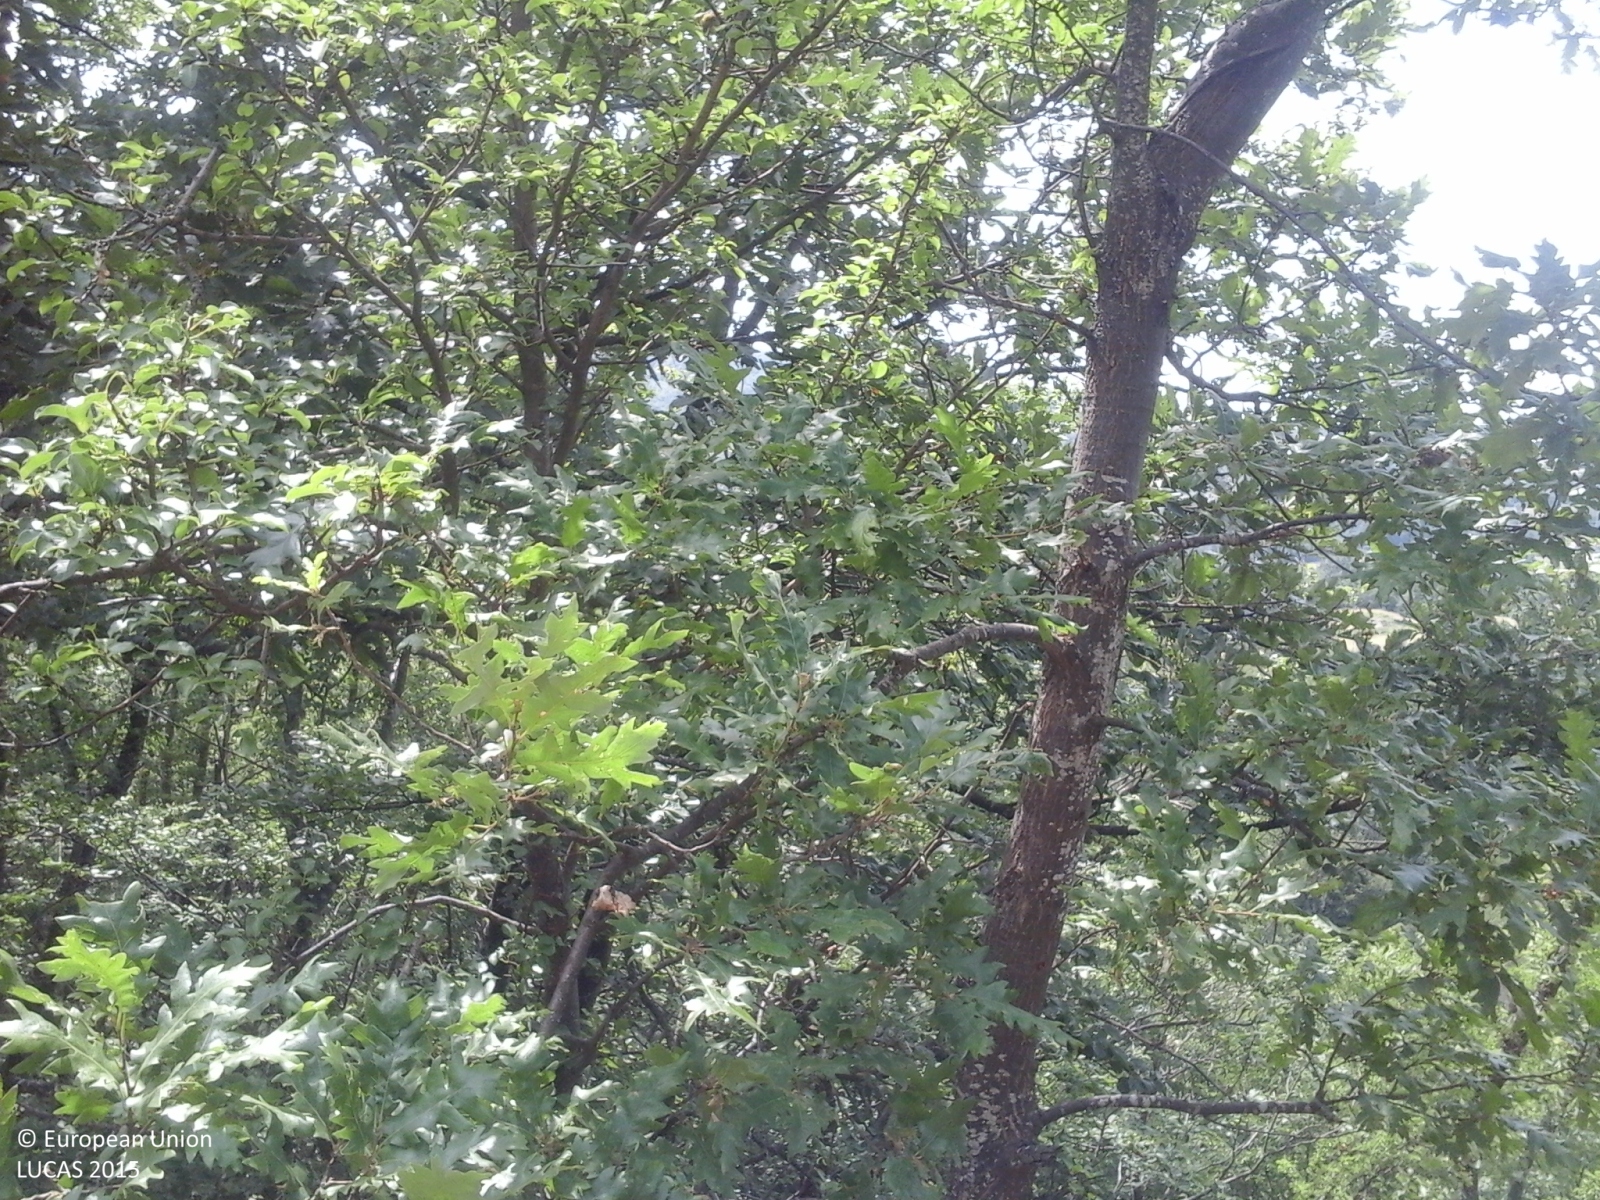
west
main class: Woodland
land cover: Broadleaved woodland
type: thermophilous deciduous forest
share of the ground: > 75 %
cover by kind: broadleaved forest trees 100 %
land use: Forestry
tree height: > 5 m
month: July
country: IT
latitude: 44.4043
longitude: 10.2881
